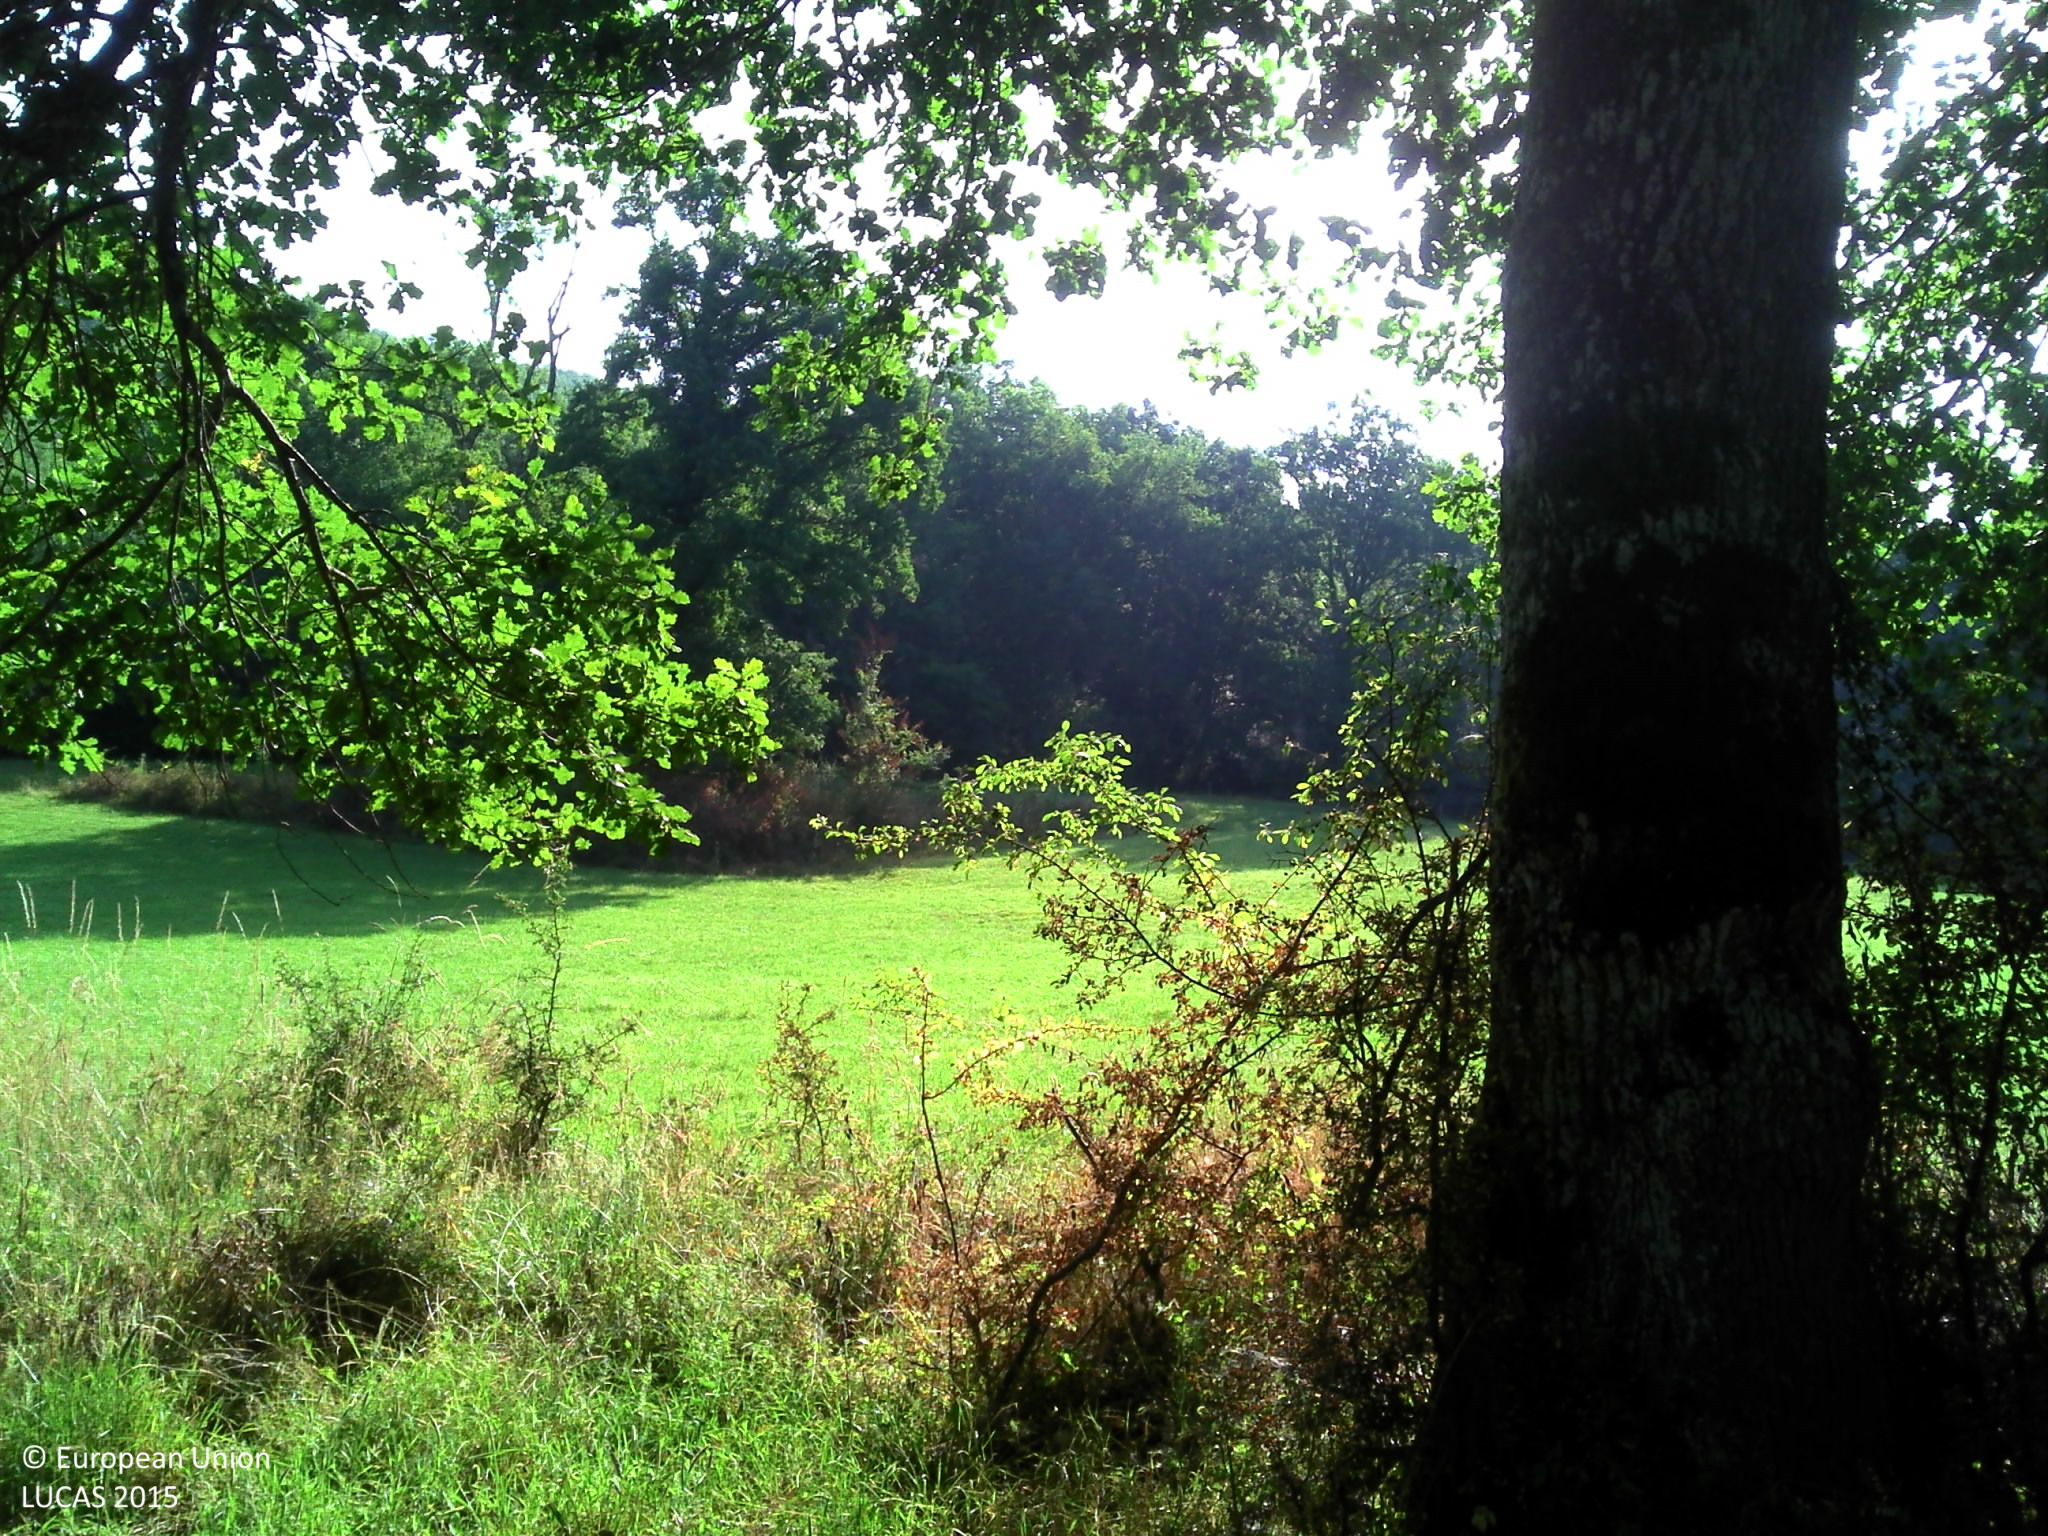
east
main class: Grassland
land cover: Grassland without tree/shrub cover
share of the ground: > 75 %
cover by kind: herbaceous plants 100 %
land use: Agriculture (excluding fallow land and kitchen gardens)
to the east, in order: Grassland without tree/shrub cover; Fences; Broadleaved woodland
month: July
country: FR
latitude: 43.0806
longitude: 1.1236
